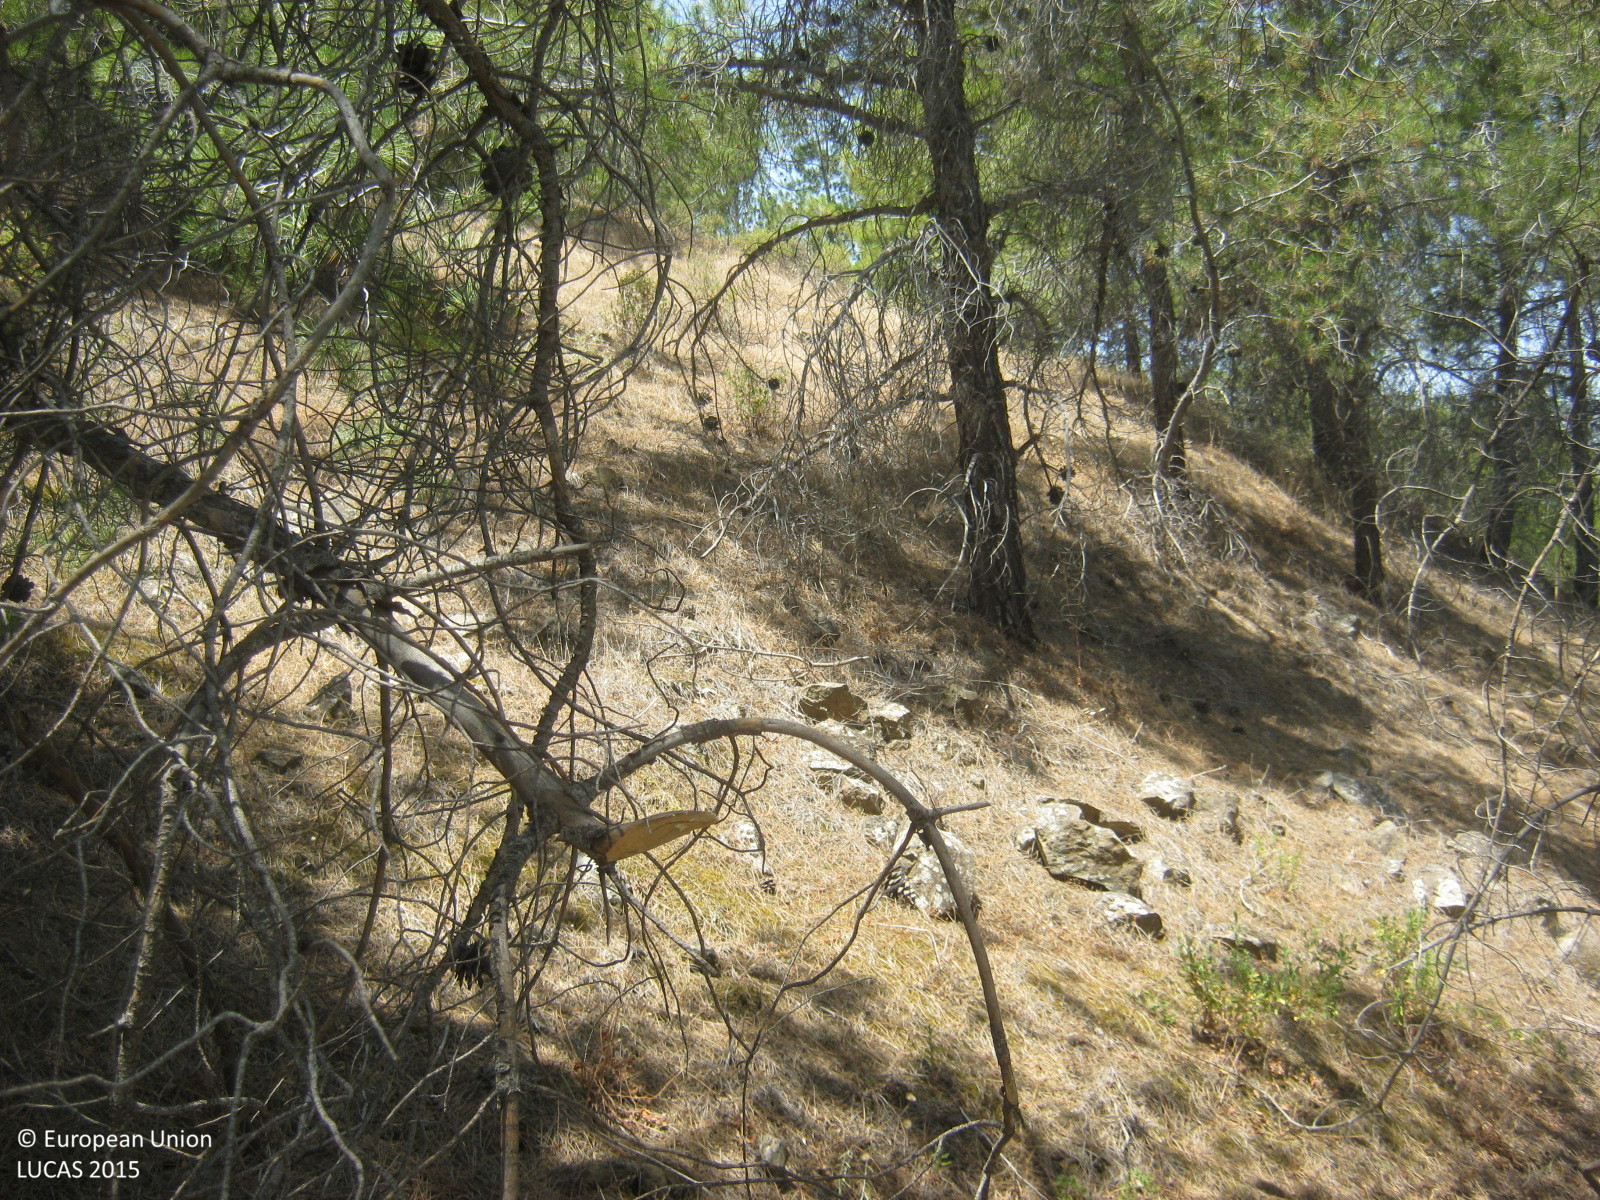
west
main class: Woodland
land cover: Pine dominated coniferous woodland
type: coniferous forest of the mediterranean region
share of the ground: > 75 %
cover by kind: coniferous forest trees 80 %, shrubs 10 %, unconsolidated bare surface 10 %
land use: Forestry
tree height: > 5 m
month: June
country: CY
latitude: 35.0195
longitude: 33.0714
